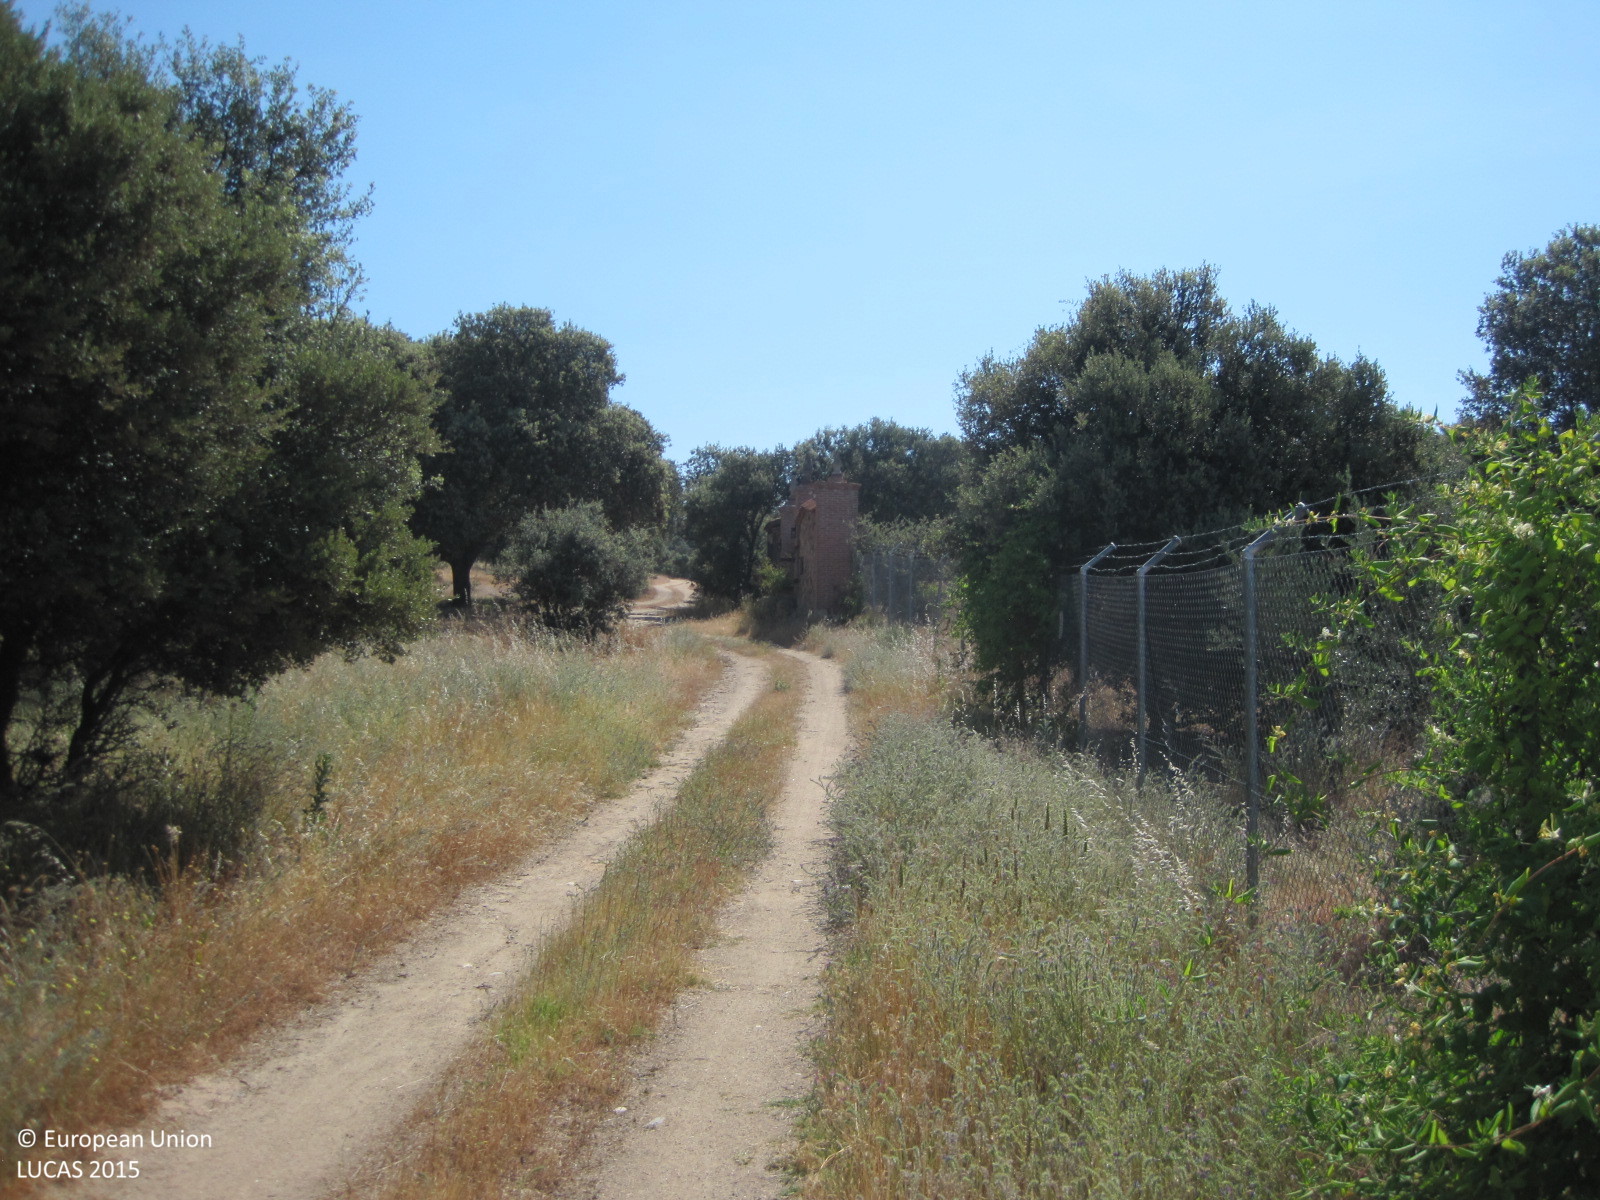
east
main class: Woodland
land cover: Broadleaved woodland
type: broadleaved evergreen forest
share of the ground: 50 - 75 %
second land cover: Grassland without tree/shrub cover
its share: 50 - 75 %
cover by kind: broadleaved forest trees 90 %, herbaceous plants 10 %
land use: Forestry
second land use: Agriculture (excluding fallow land and kitchen gardens)
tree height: < 5 m
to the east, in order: Broadleaved woodland; Grassland without tree/shrub cover; Fences; Broadleaved woodland; Tracks; Grass margins; Artificial constructions in urban areas; Broadleaved woodland; Fences; Broadleaved woodland; Tracks; Broadleaved woodland
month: June
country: ES
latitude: 40.0901
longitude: -4.8159
